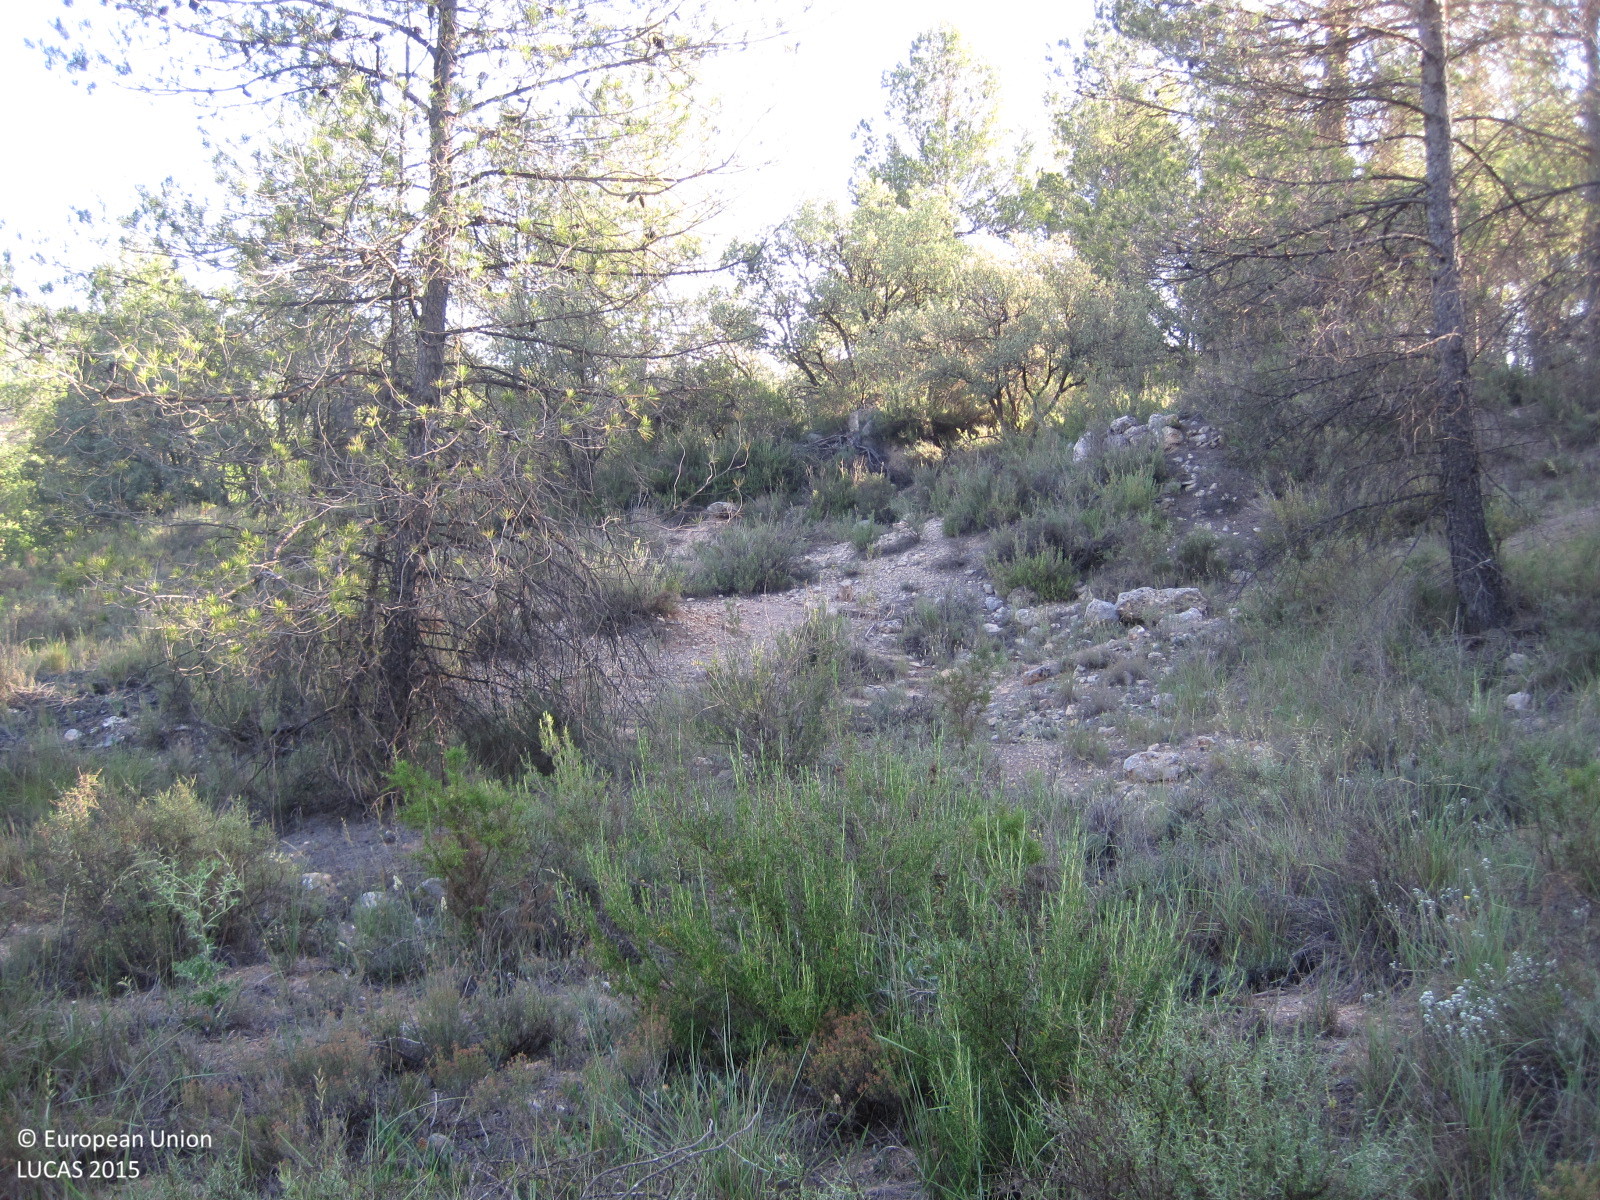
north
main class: Woodland
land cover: Pine dominated coniferous woodland
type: coniferous forest of the mediterranean region
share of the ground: 10 - 25 %
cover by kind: herbaceous plants 60 %, coniferous forest trees 20 %, shrubs 15 %, consolidated bare surface 5 %
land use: Forestry
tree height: > 5 m
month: June
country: ES
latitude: 39.3482
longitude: -1.0578
